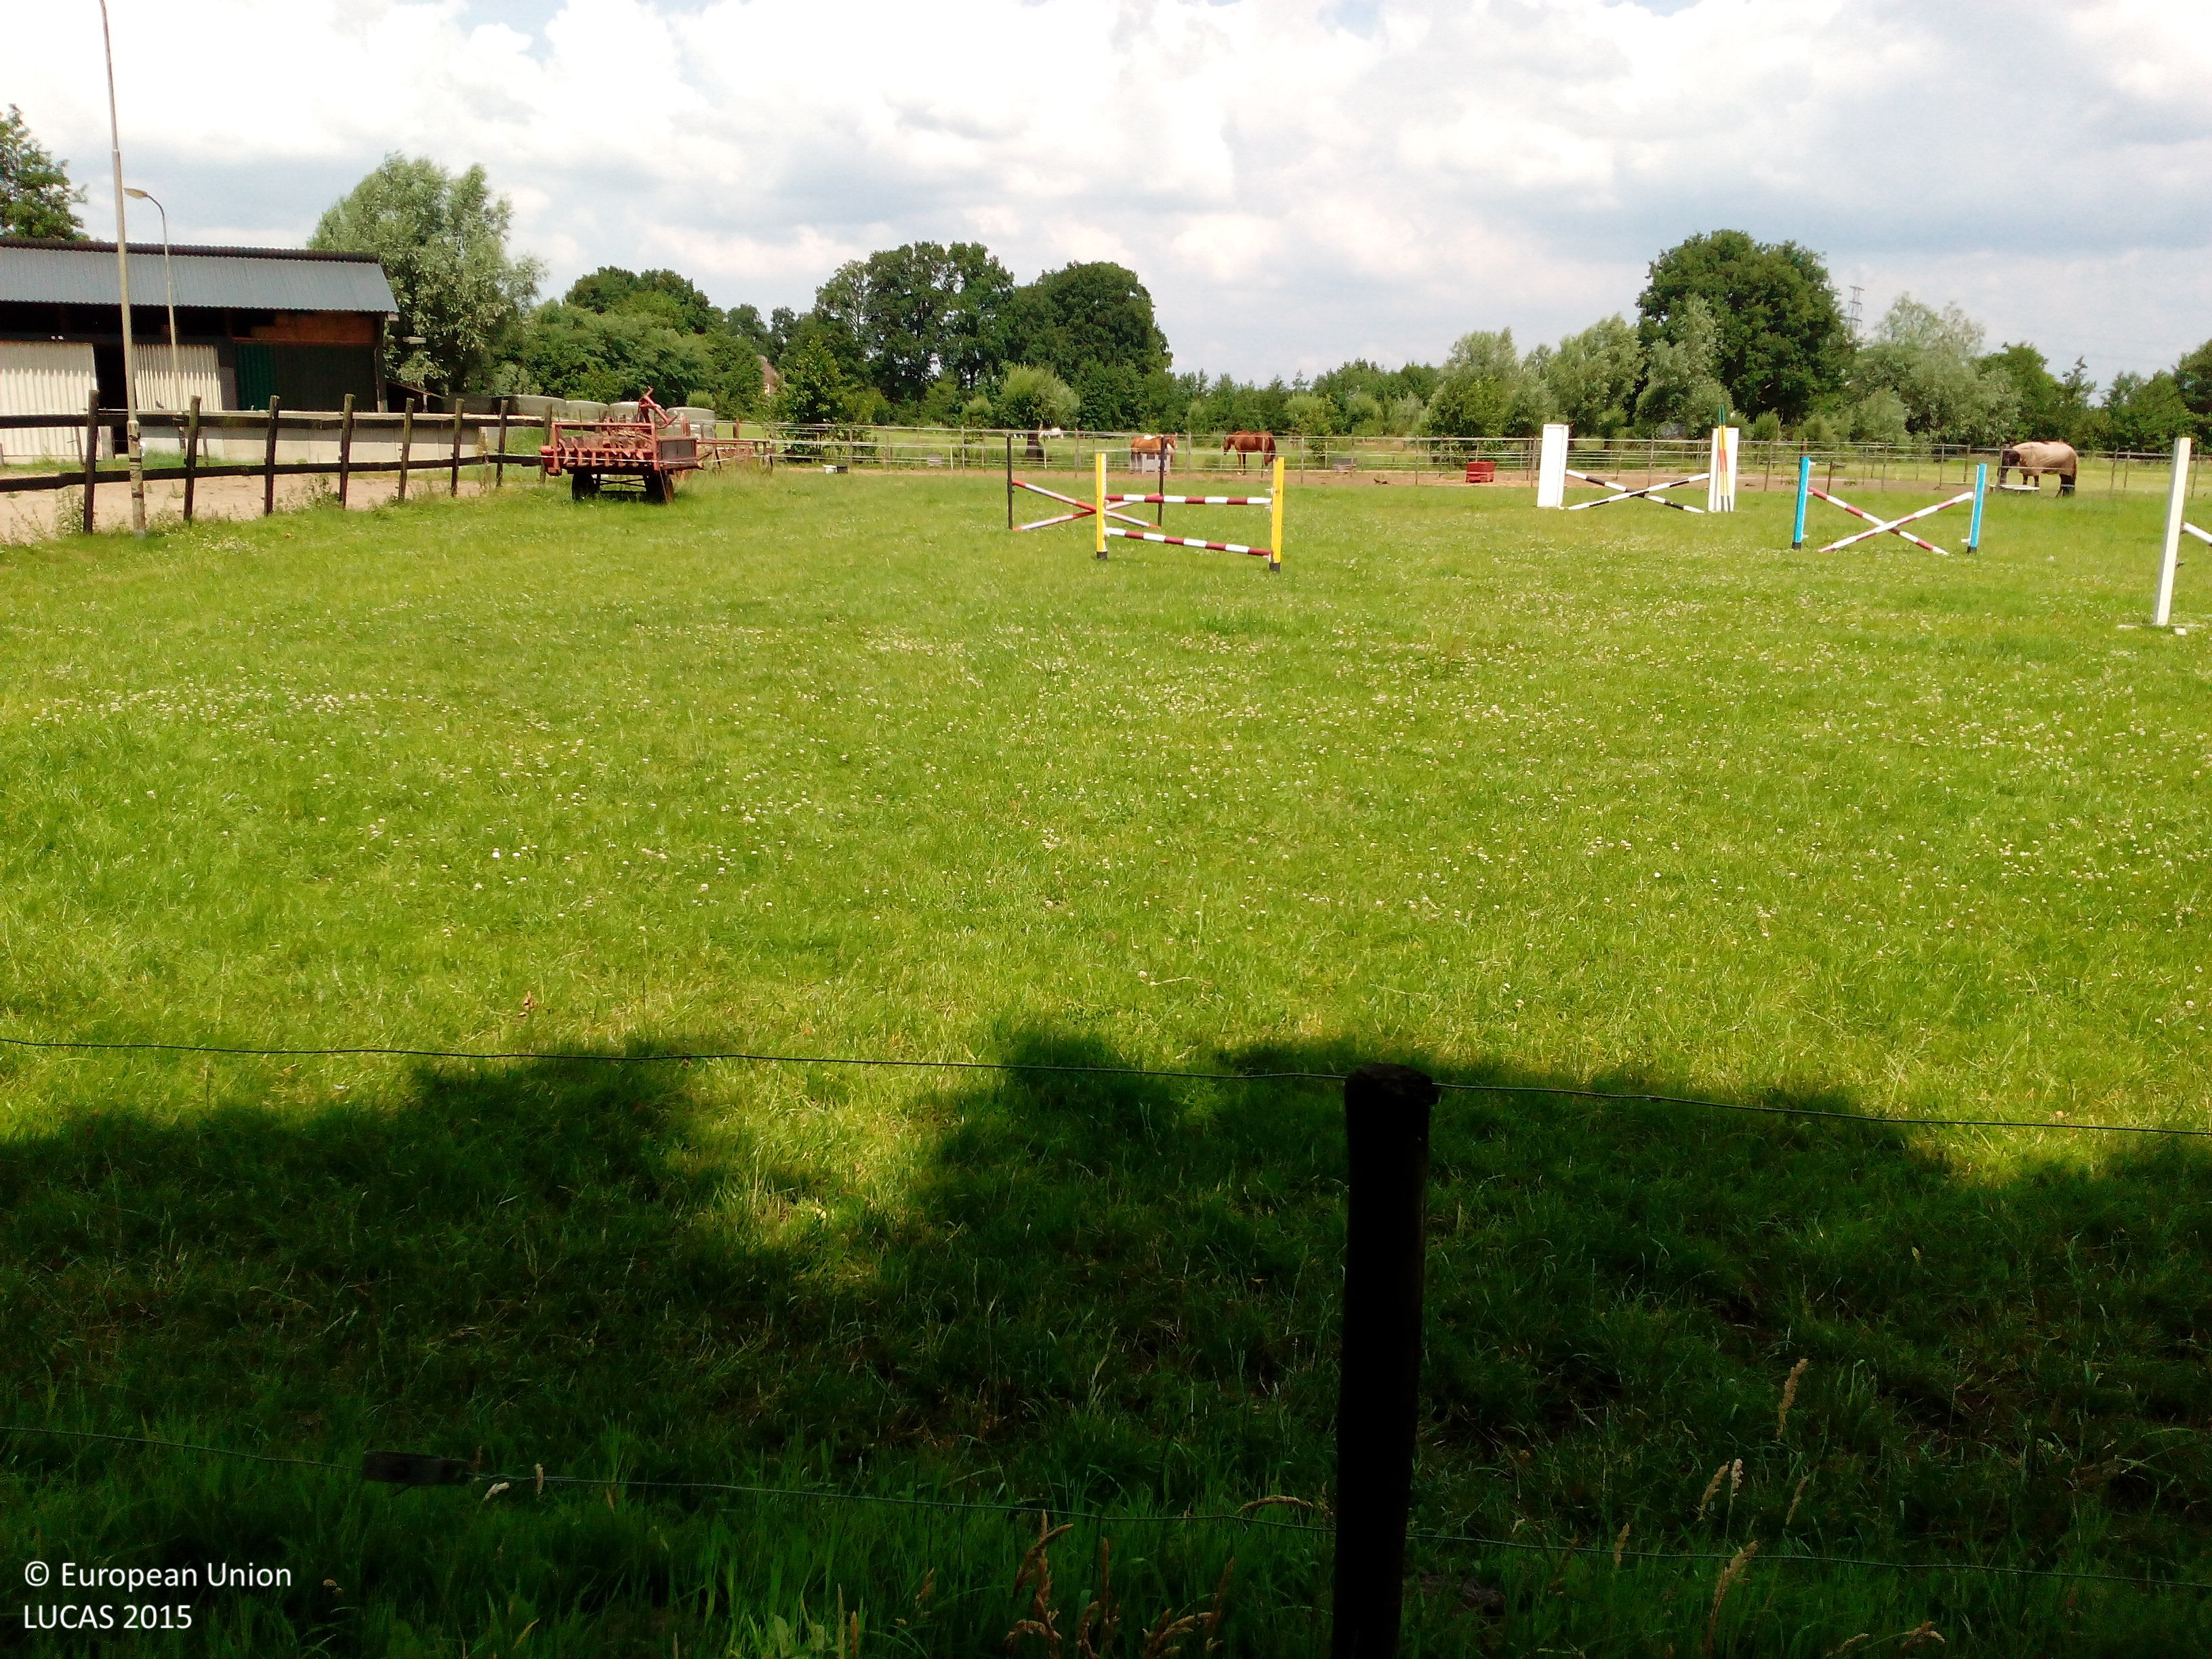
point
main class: Grassland
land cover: Grassland without tree/shrub cover
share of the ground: > 75 %
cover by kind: herbaceous plants 100 %
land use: Agriculture (excluding fallow land and kitchen gardens)
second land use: Sport
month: June
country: NL
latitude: 52.2204
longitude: 5.5045
